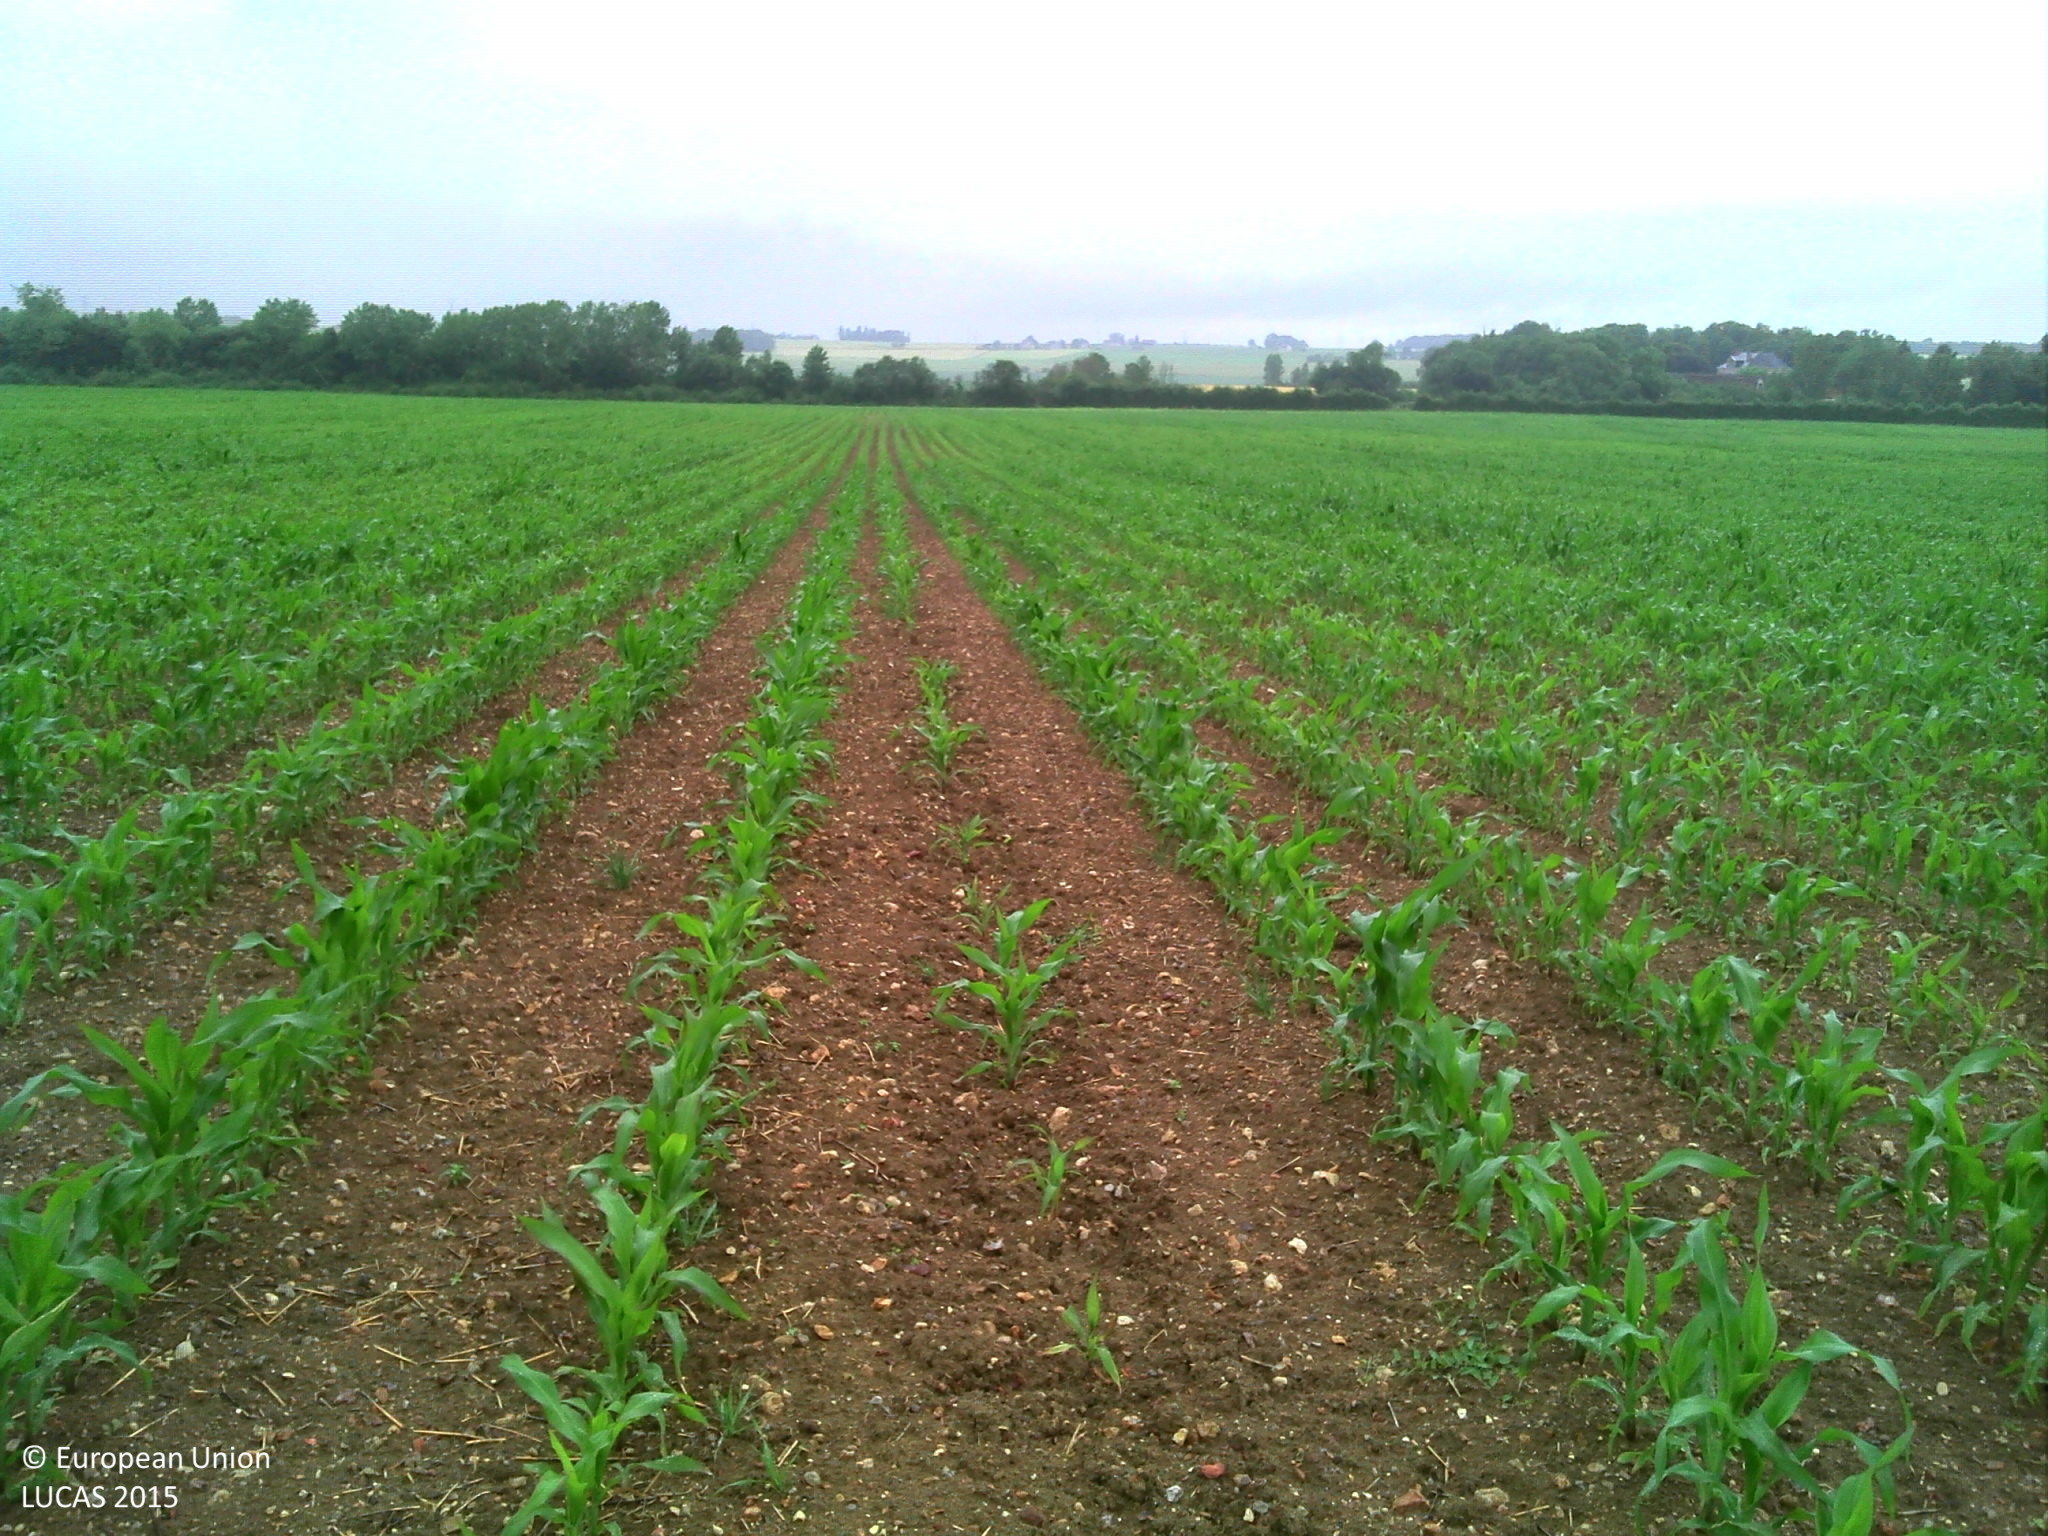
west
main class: Cropland
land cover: Maize
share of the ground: 10 - 25 %
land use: Agriculture (excluding fallow land and kitchen gardens)
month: June
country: FR
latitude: 47.6084
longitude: 0.6544
